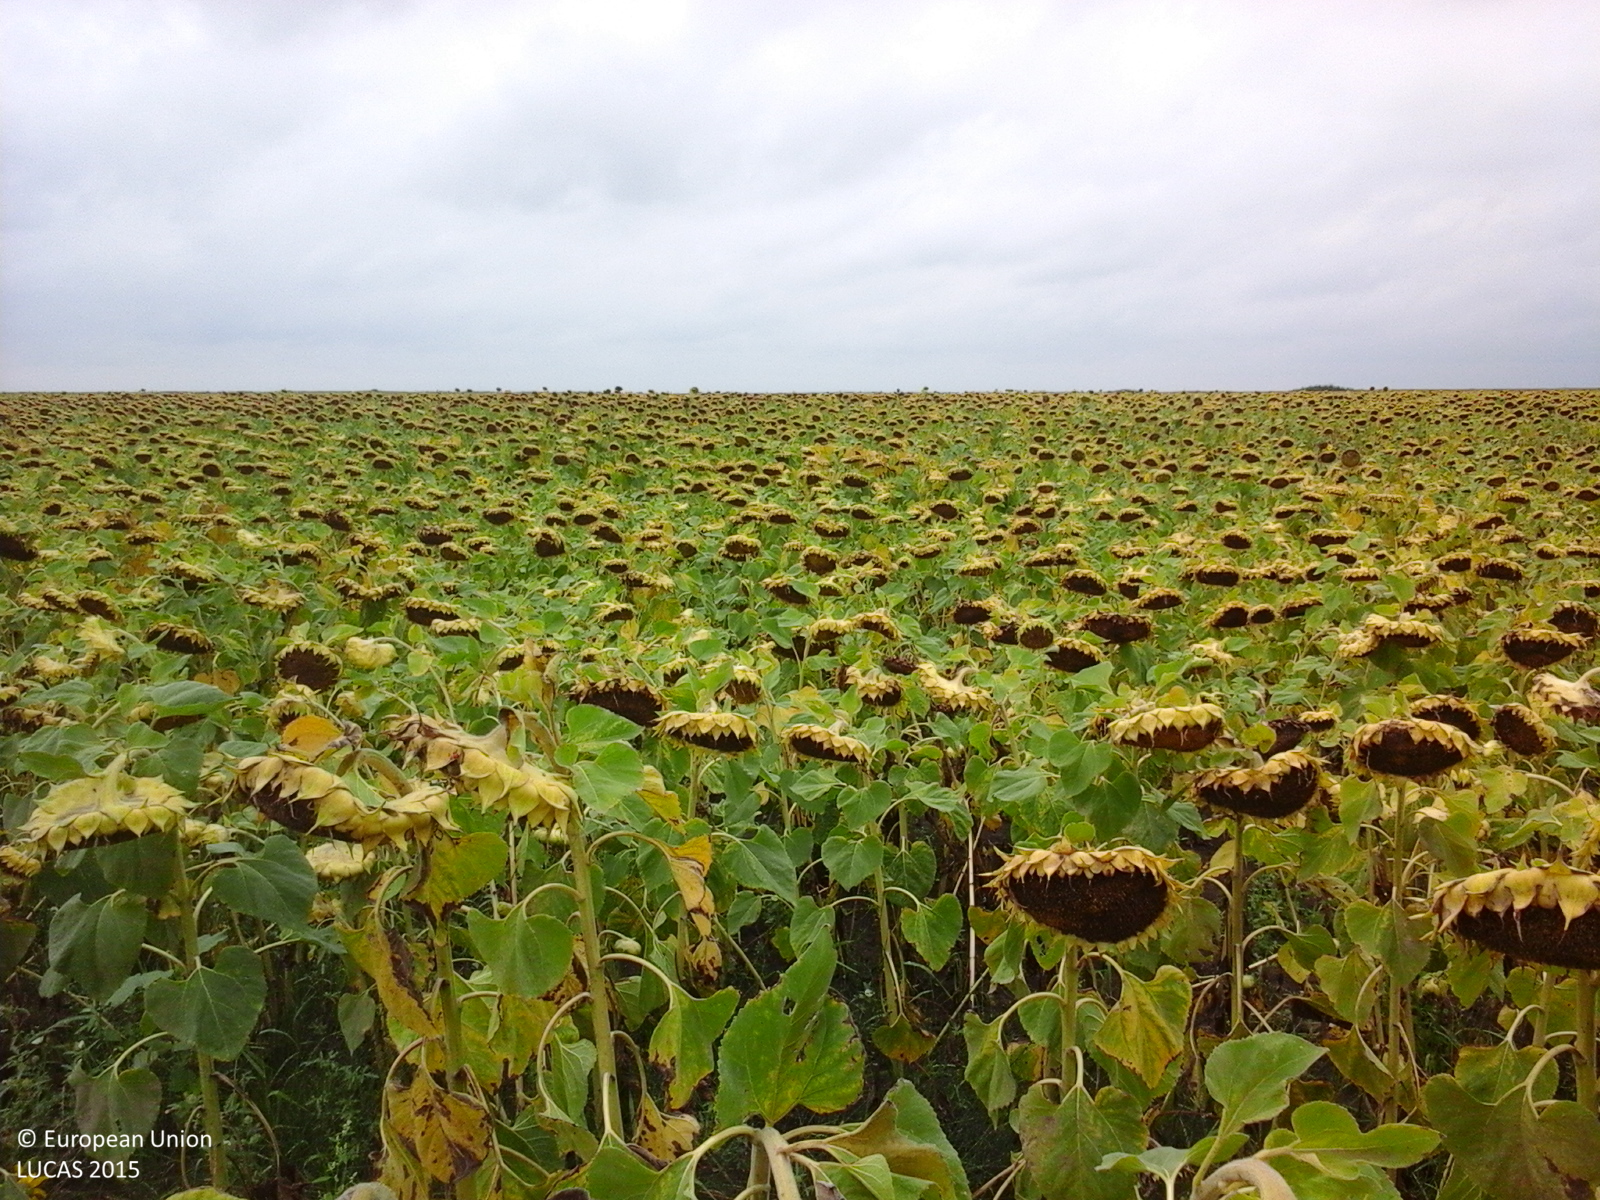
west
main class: Cropland
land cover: Sunflower
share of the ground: > 75 %
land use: Agriculture (excluding fallow land and kitchen gardens)
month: August
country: RO
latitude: 46.0859
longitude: 20.5129
